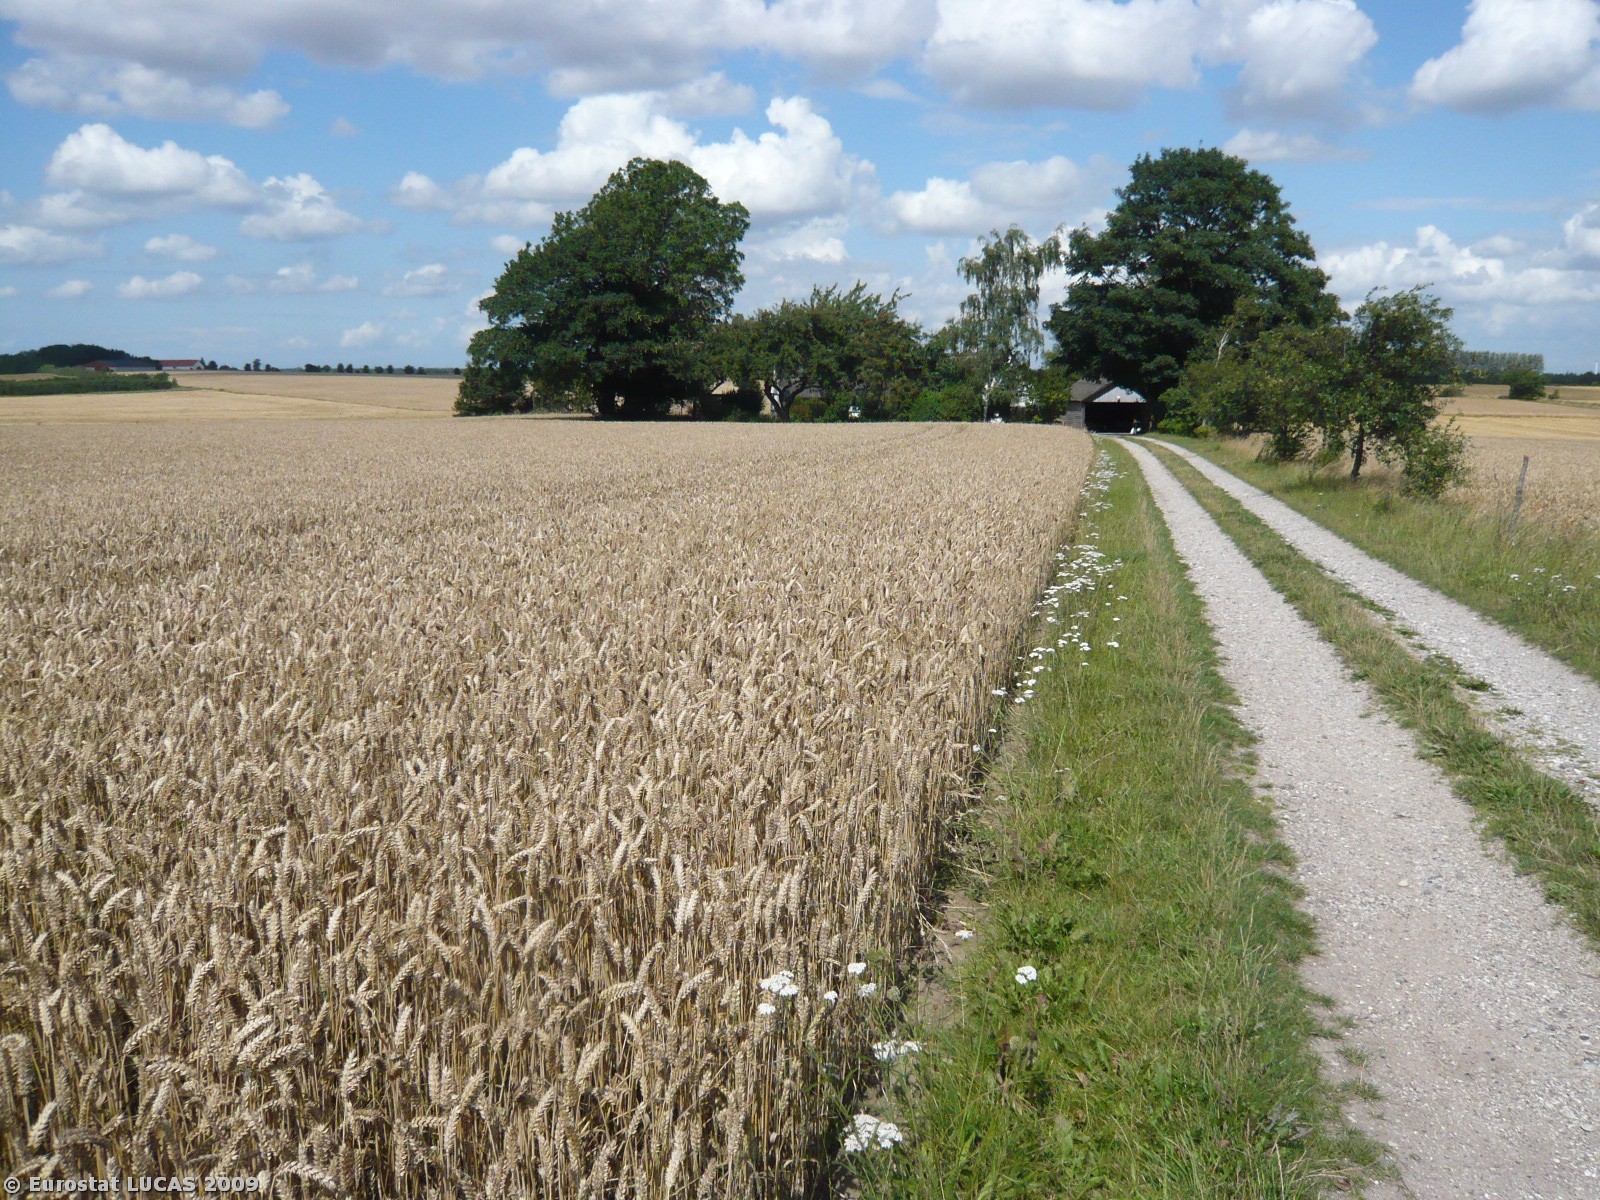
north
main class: Cropland
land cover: Common wheat
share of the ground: > 75 %
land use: Agriculture (excluding fallow land and kitchen gardens)
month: July
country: DK
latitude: 55.5596
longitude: 12.0753
